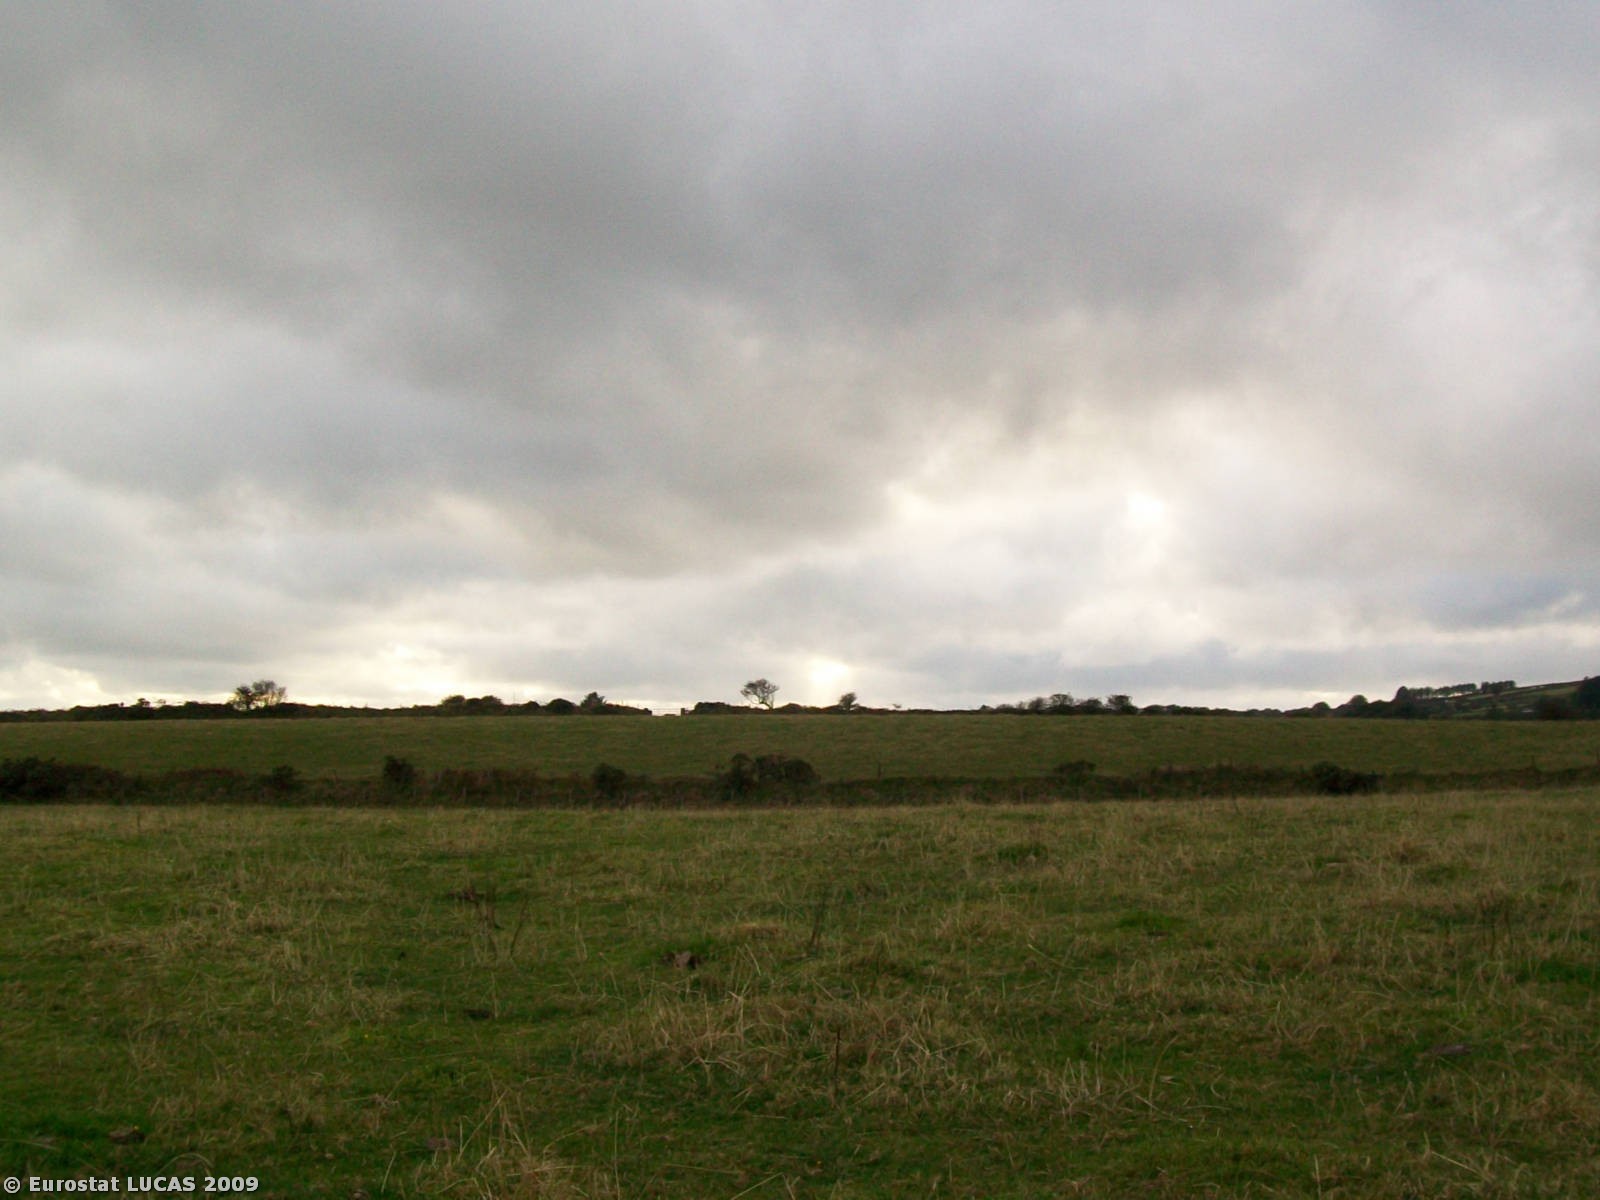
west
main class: Grassland
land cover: Grassland without tree/shrub cover
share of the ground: > 75 %
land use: Agriculture (excluding fallow land and kitchen gardens)
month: September
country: GB
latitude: 51.9204
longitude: -4.7828
